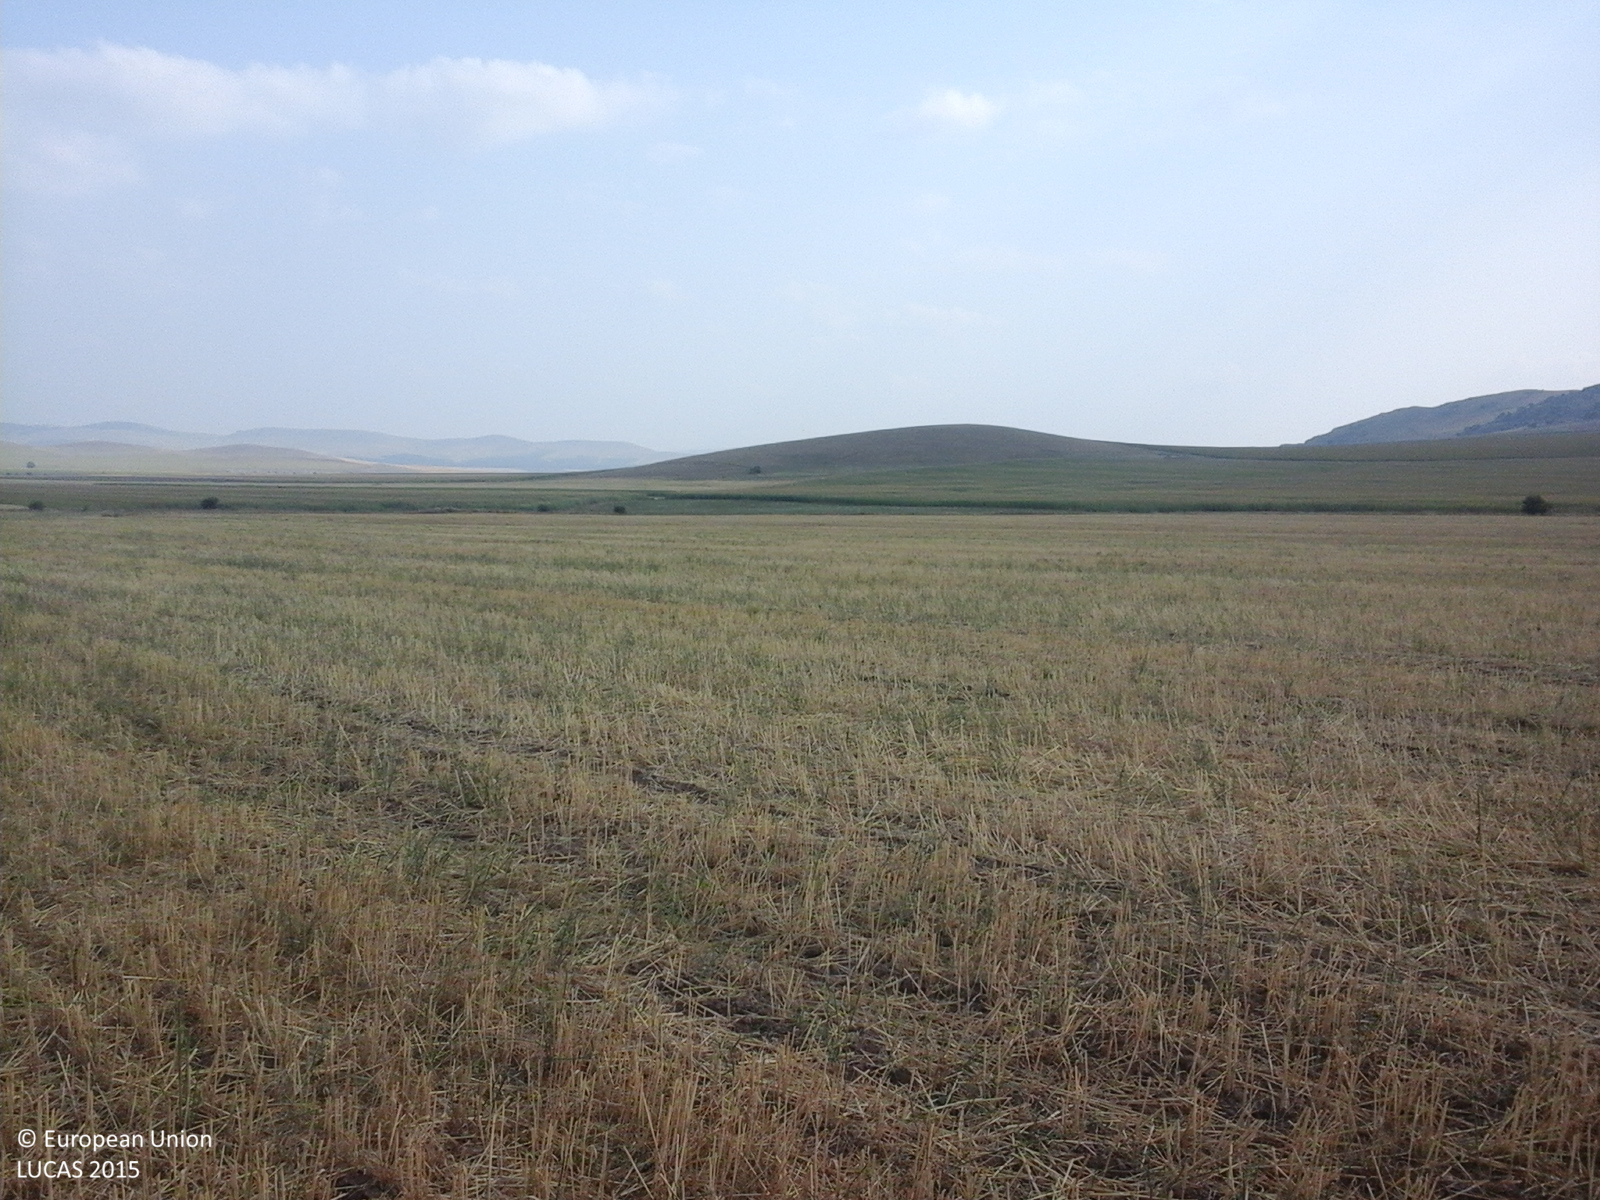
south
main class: Cropland
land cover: Common wheat
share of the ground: > 75 %
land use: Agriculture (excluding fallow land and kitchen gardens)
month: July
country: RO
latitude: 45.0950
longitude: 28.2545
